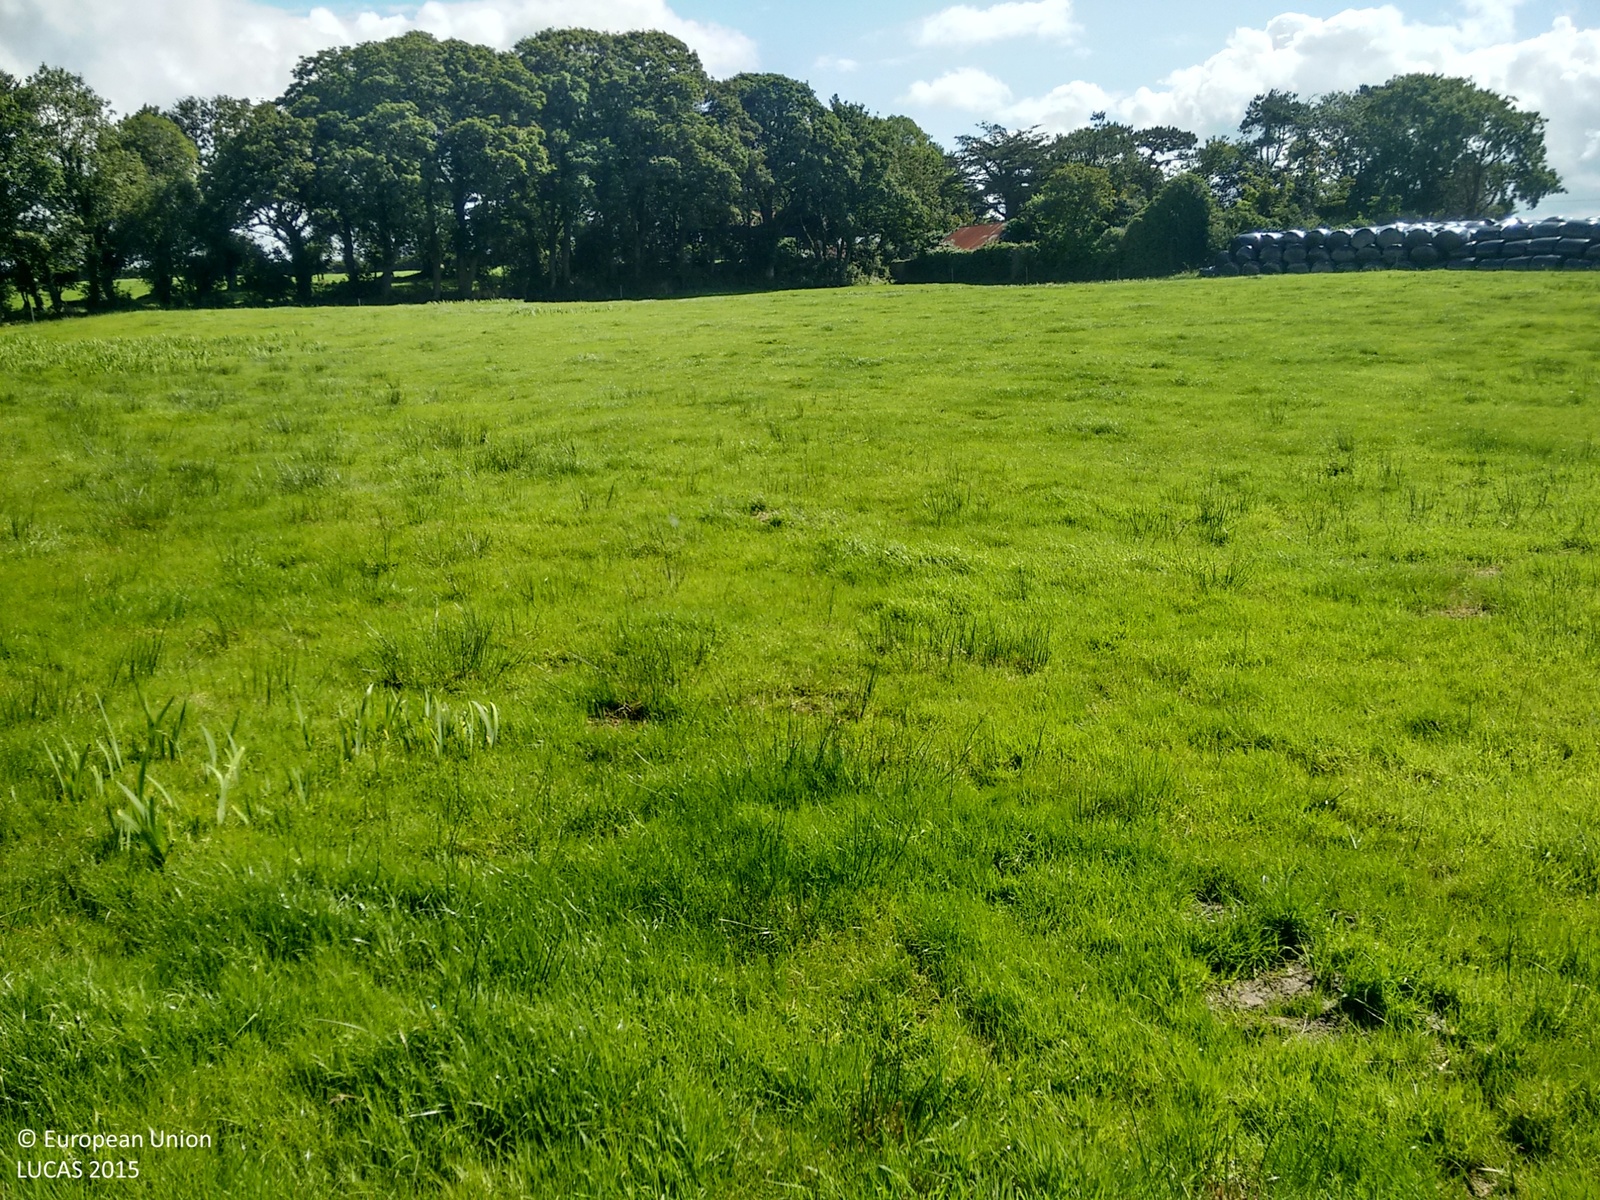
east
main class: Grassland
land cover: Grassland without tree/shrub cover
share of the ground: > 75 %
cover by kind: herbaceous plants 100 %
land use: Agriculture (excluding fallow land and kitchen gardens)
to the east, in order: Grassland without tree/shrub cover; Fences; Abandoned hedges; Ditches and canals; Fences; Grassland without tree/shrub cover; Broadleaved woodland; Spontaneously vegetated surfaces; Artificial constructions; Fences; Broadleaved woodland; Grassland without tree/shrub cover
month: August
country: IE
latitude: 52.1932
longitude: -9.6521
